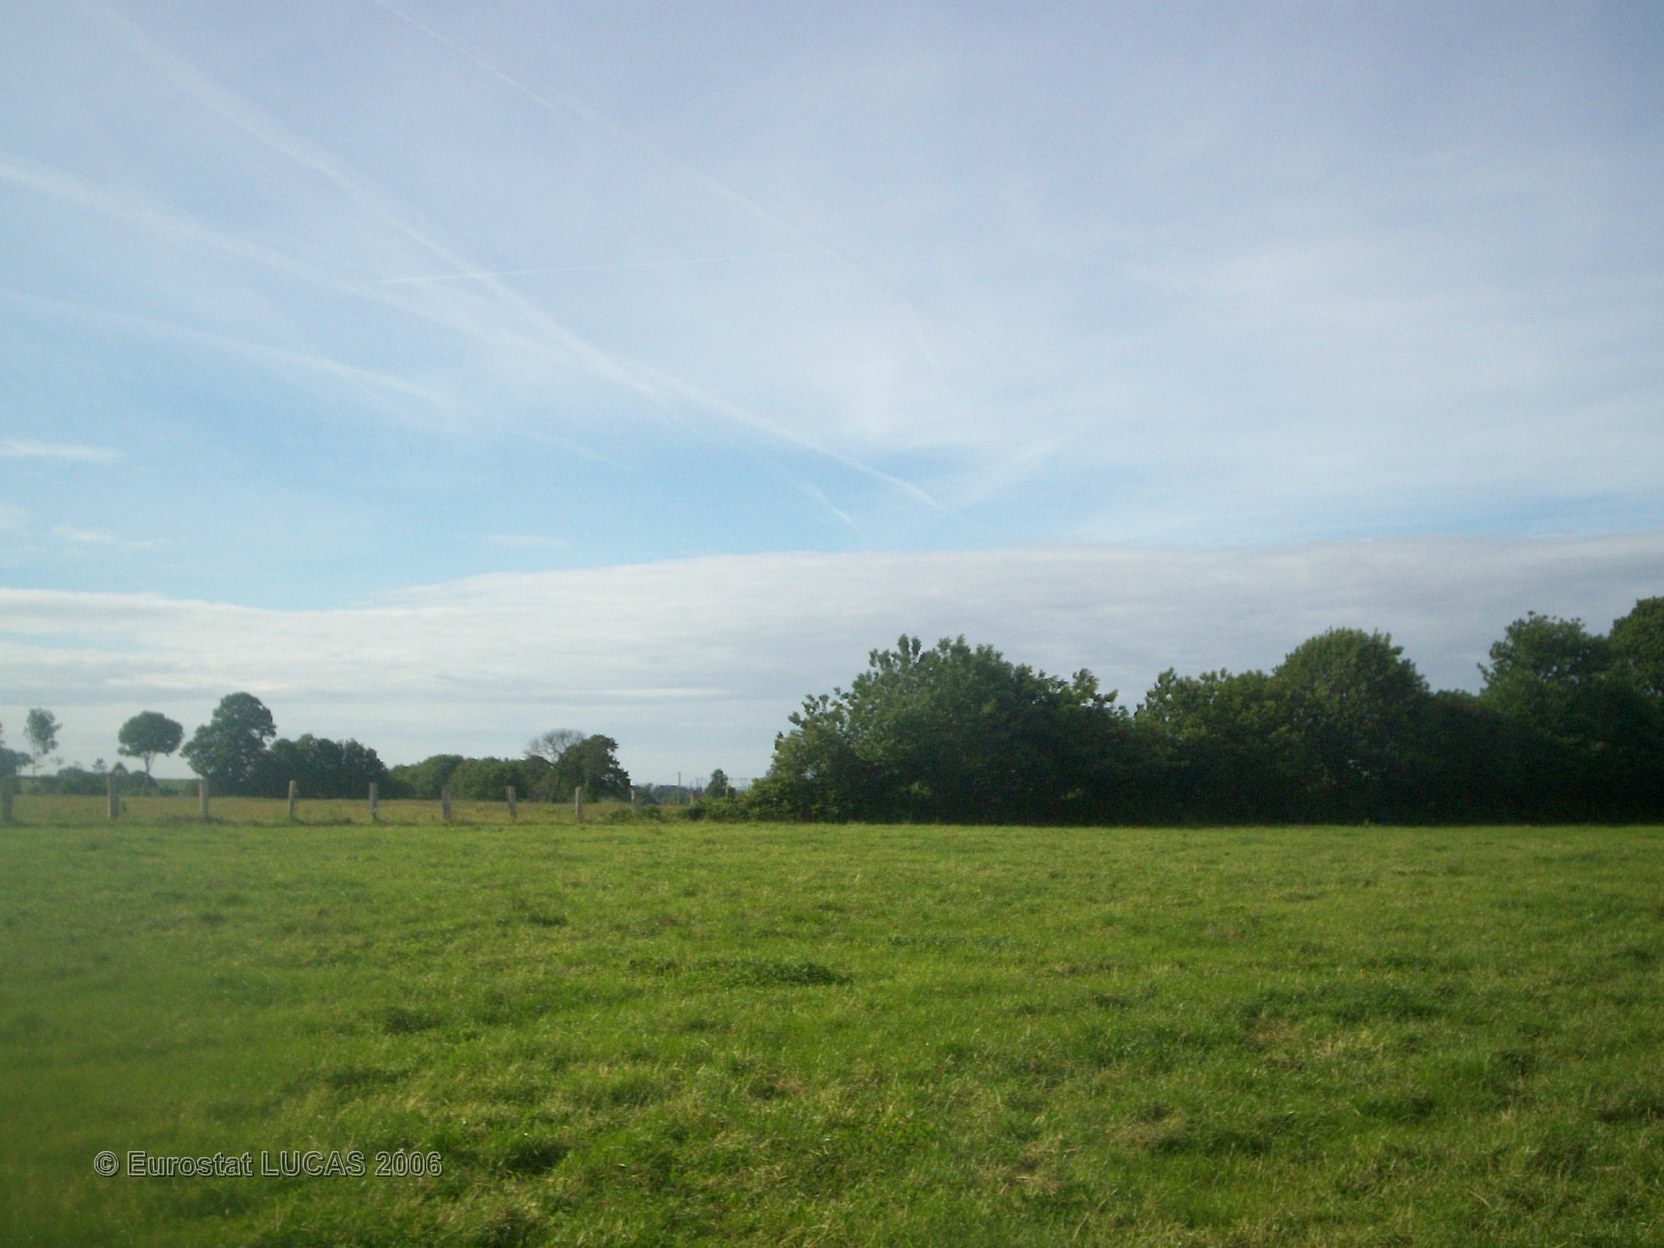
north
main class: Grassland
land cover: Grassland without tree/shrub cover
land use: Agriculture (excluding fallow land and kitchen gardens)
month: June
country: FR
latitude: 48.5364
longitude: -1.2442
